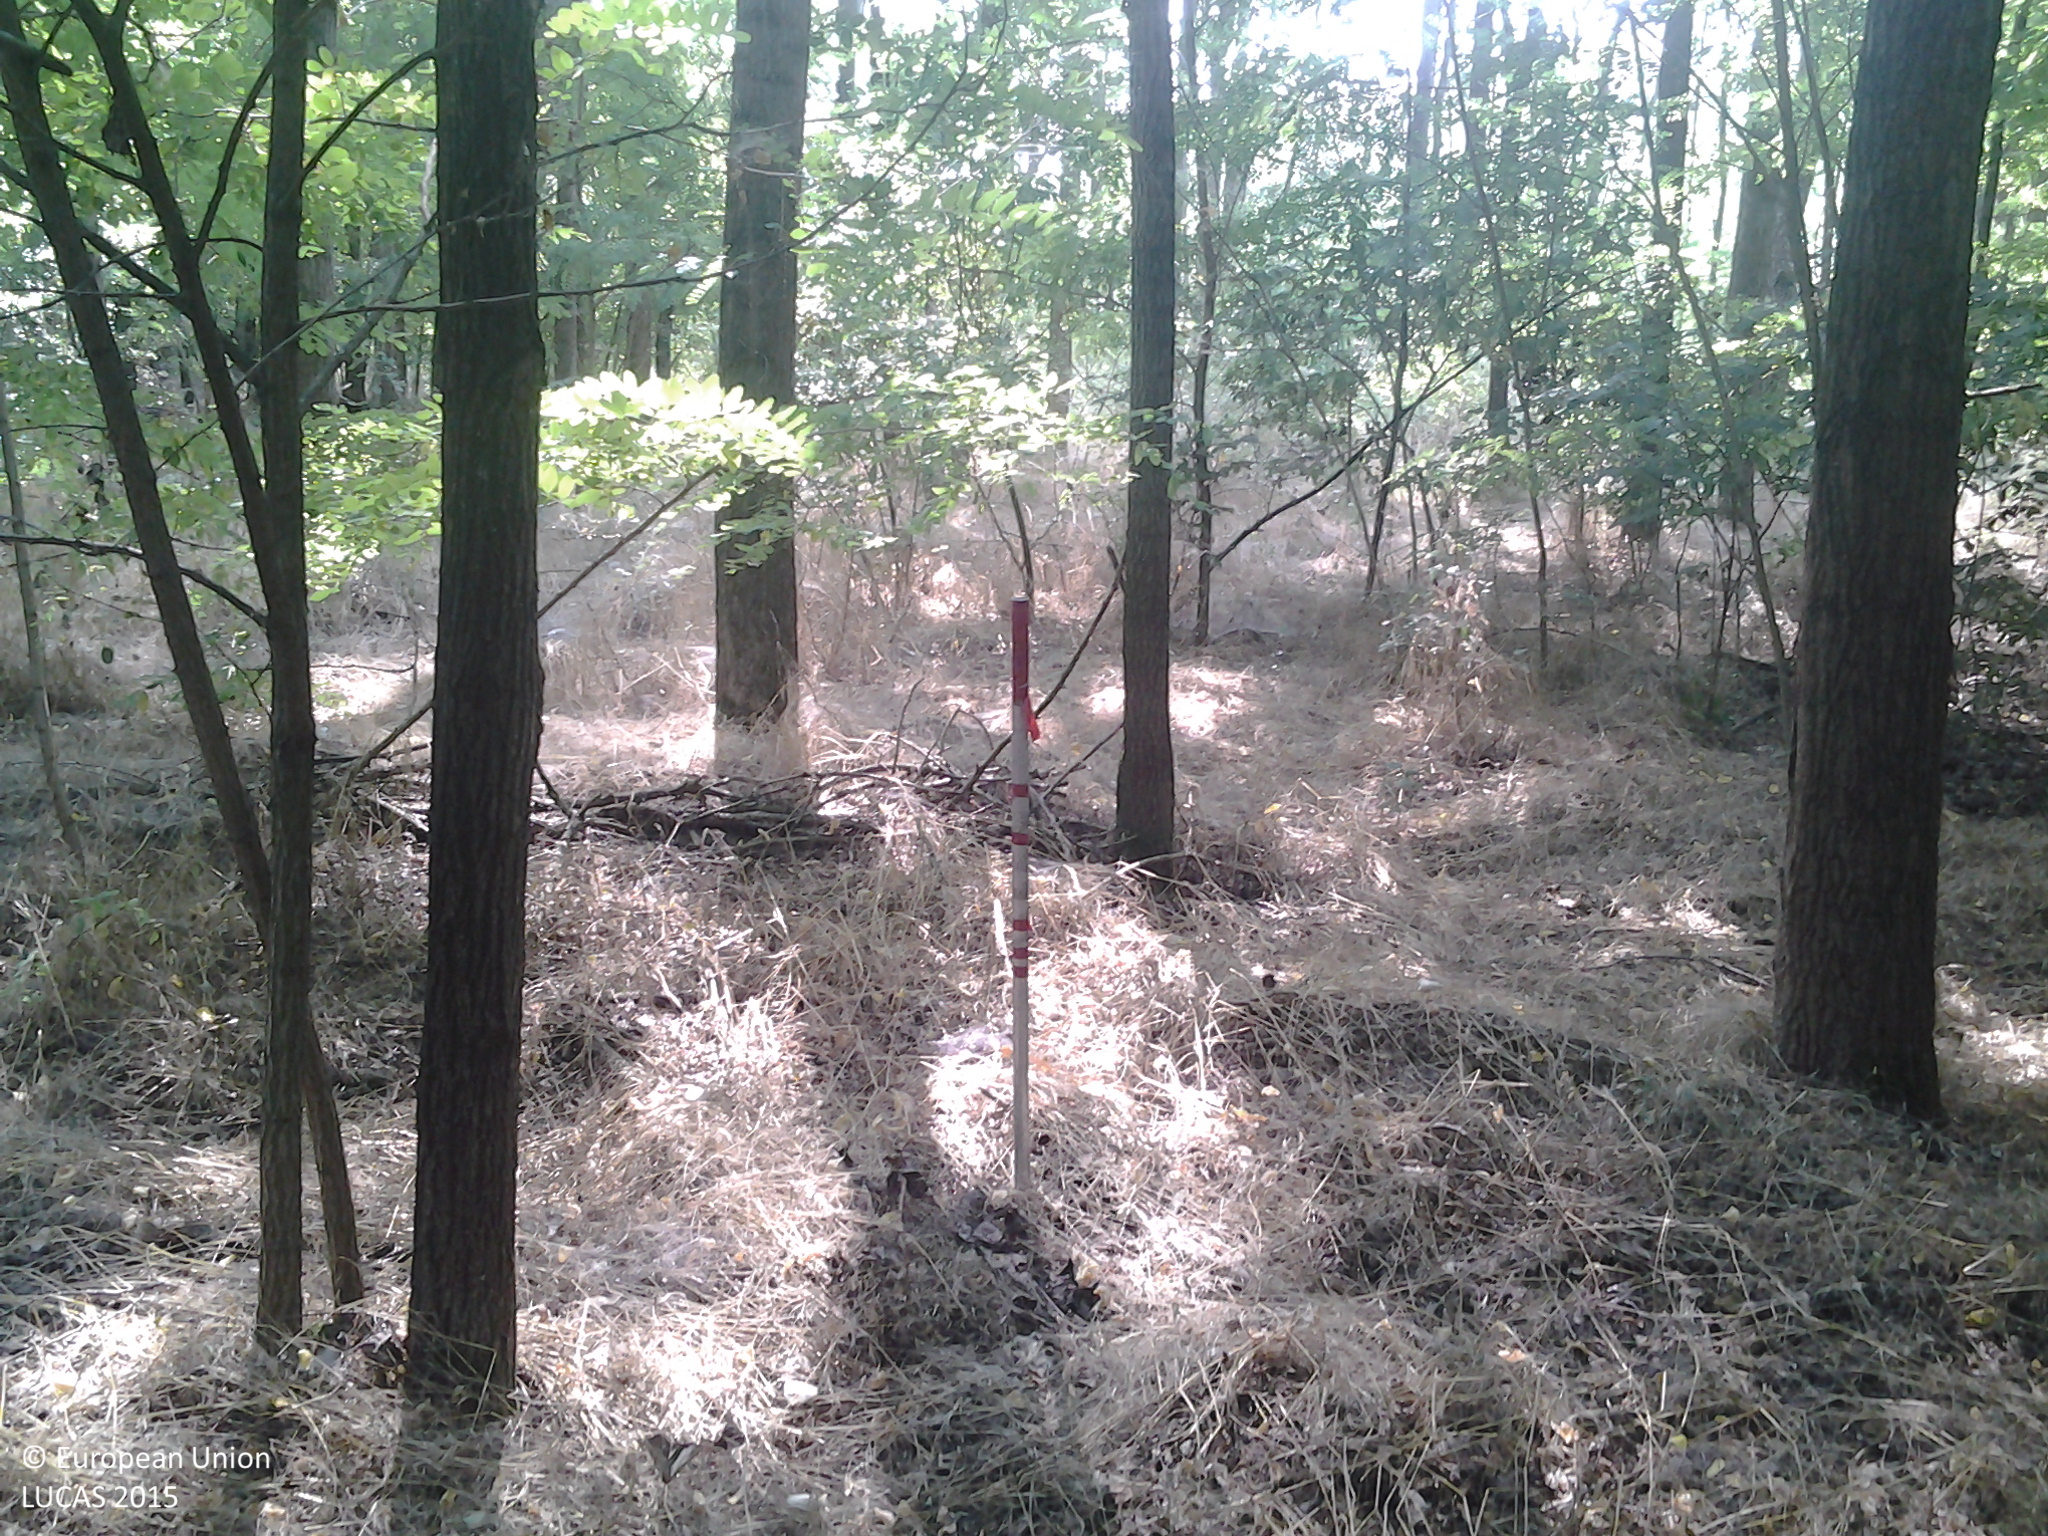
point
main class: Woodland
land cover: Broadleaved woodland
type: exotic forest
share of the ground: 50 - 75 %
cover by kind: broadleaved forest trees 70 %, herbaceous plants 30 %
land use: Forestry
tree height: > 5 m
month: July
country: HU
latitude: 46.8767
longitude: 19.0030
